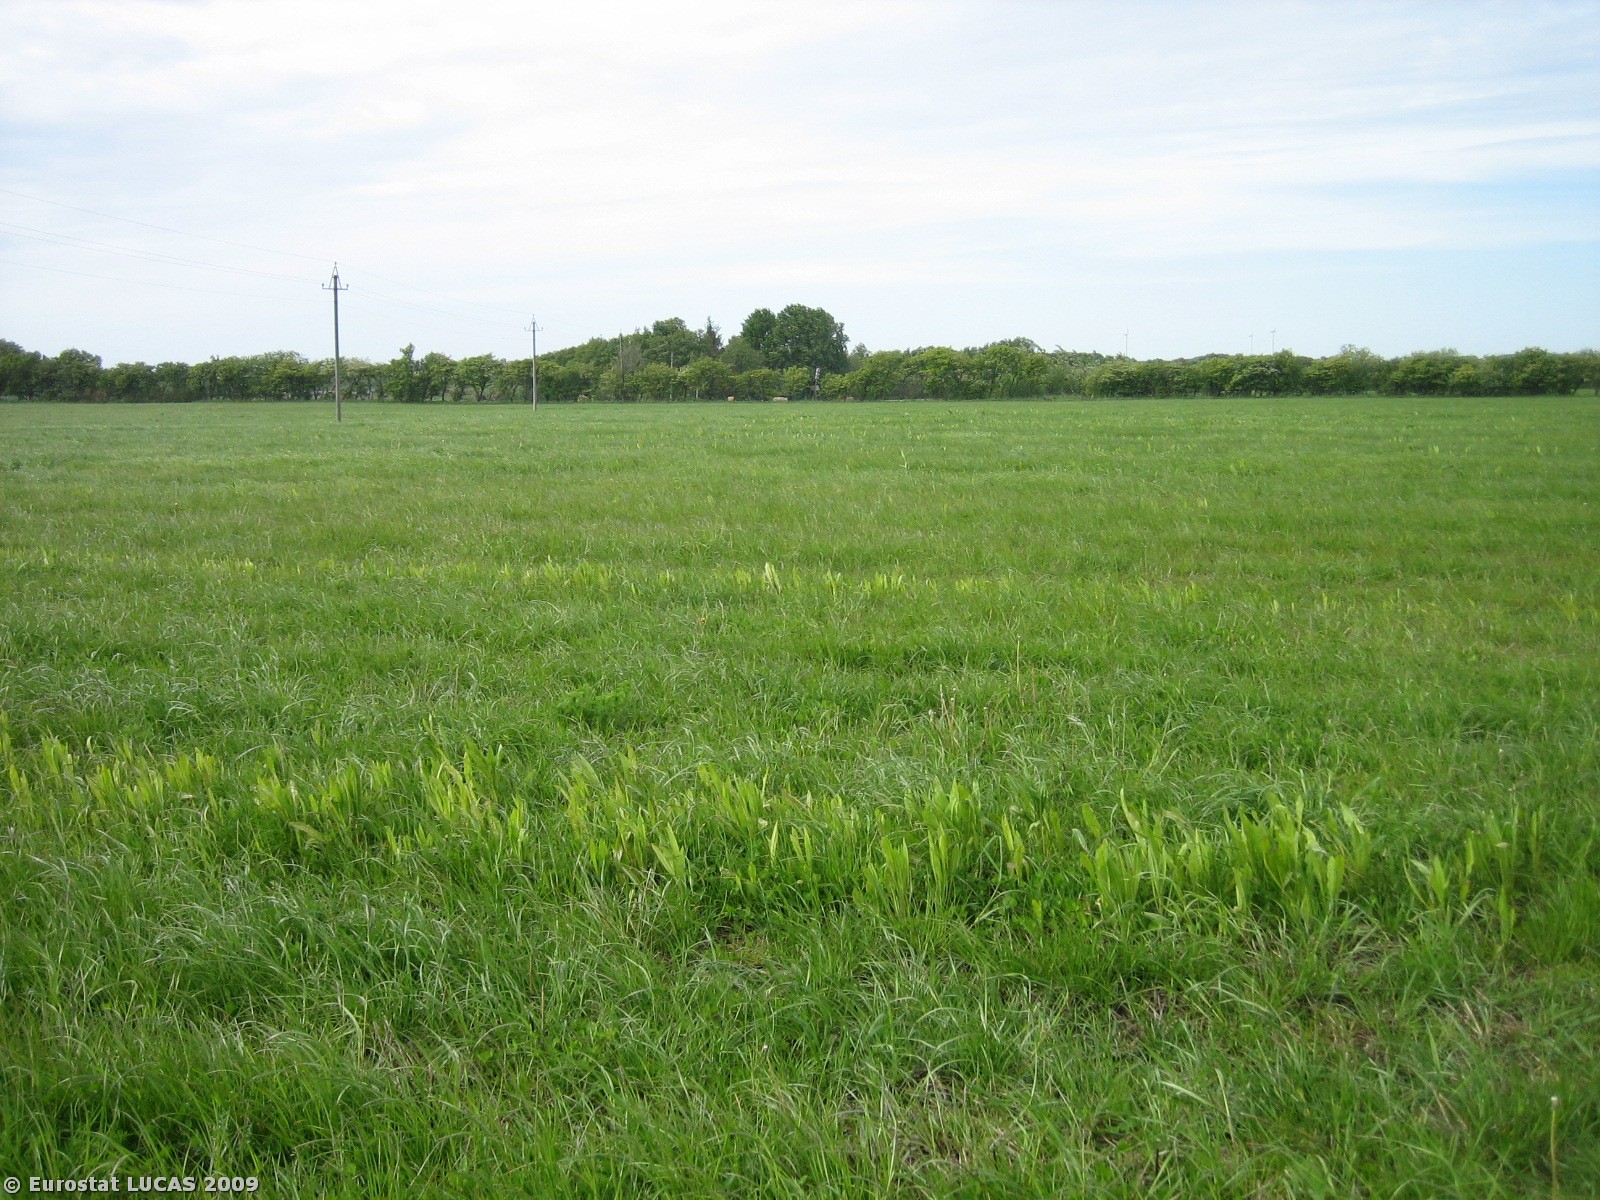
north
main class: Grassland
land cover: Grassland without tree/shrub cover
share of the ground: > 75 %
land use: Agriculture (excluding fallow land and kitchen gardens)
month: May
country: DK
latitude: 56.0341
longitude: 8.4128
